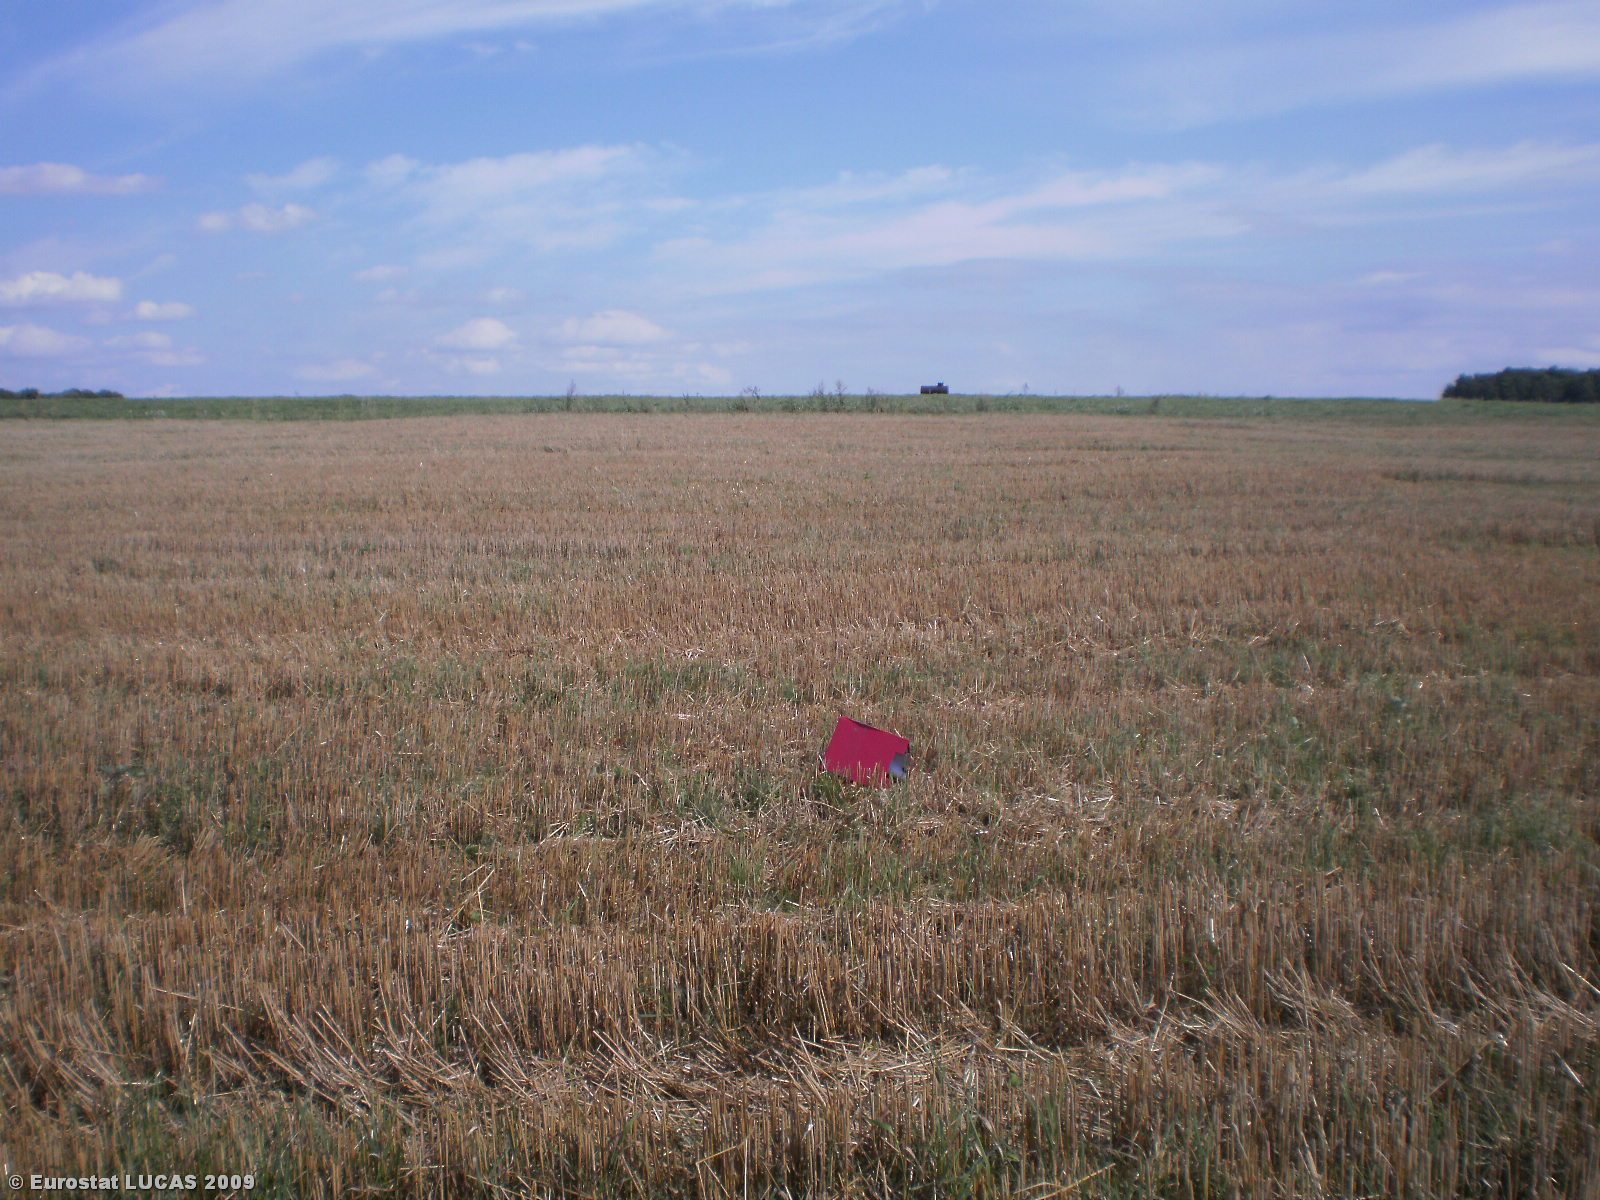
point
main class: Cropland
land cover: Common wheat
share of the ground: < 10 %
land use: Agriculture (excluding fallow land and kitchen gardens)
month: August
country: LT
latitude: 55.0867
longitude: 24.6275
